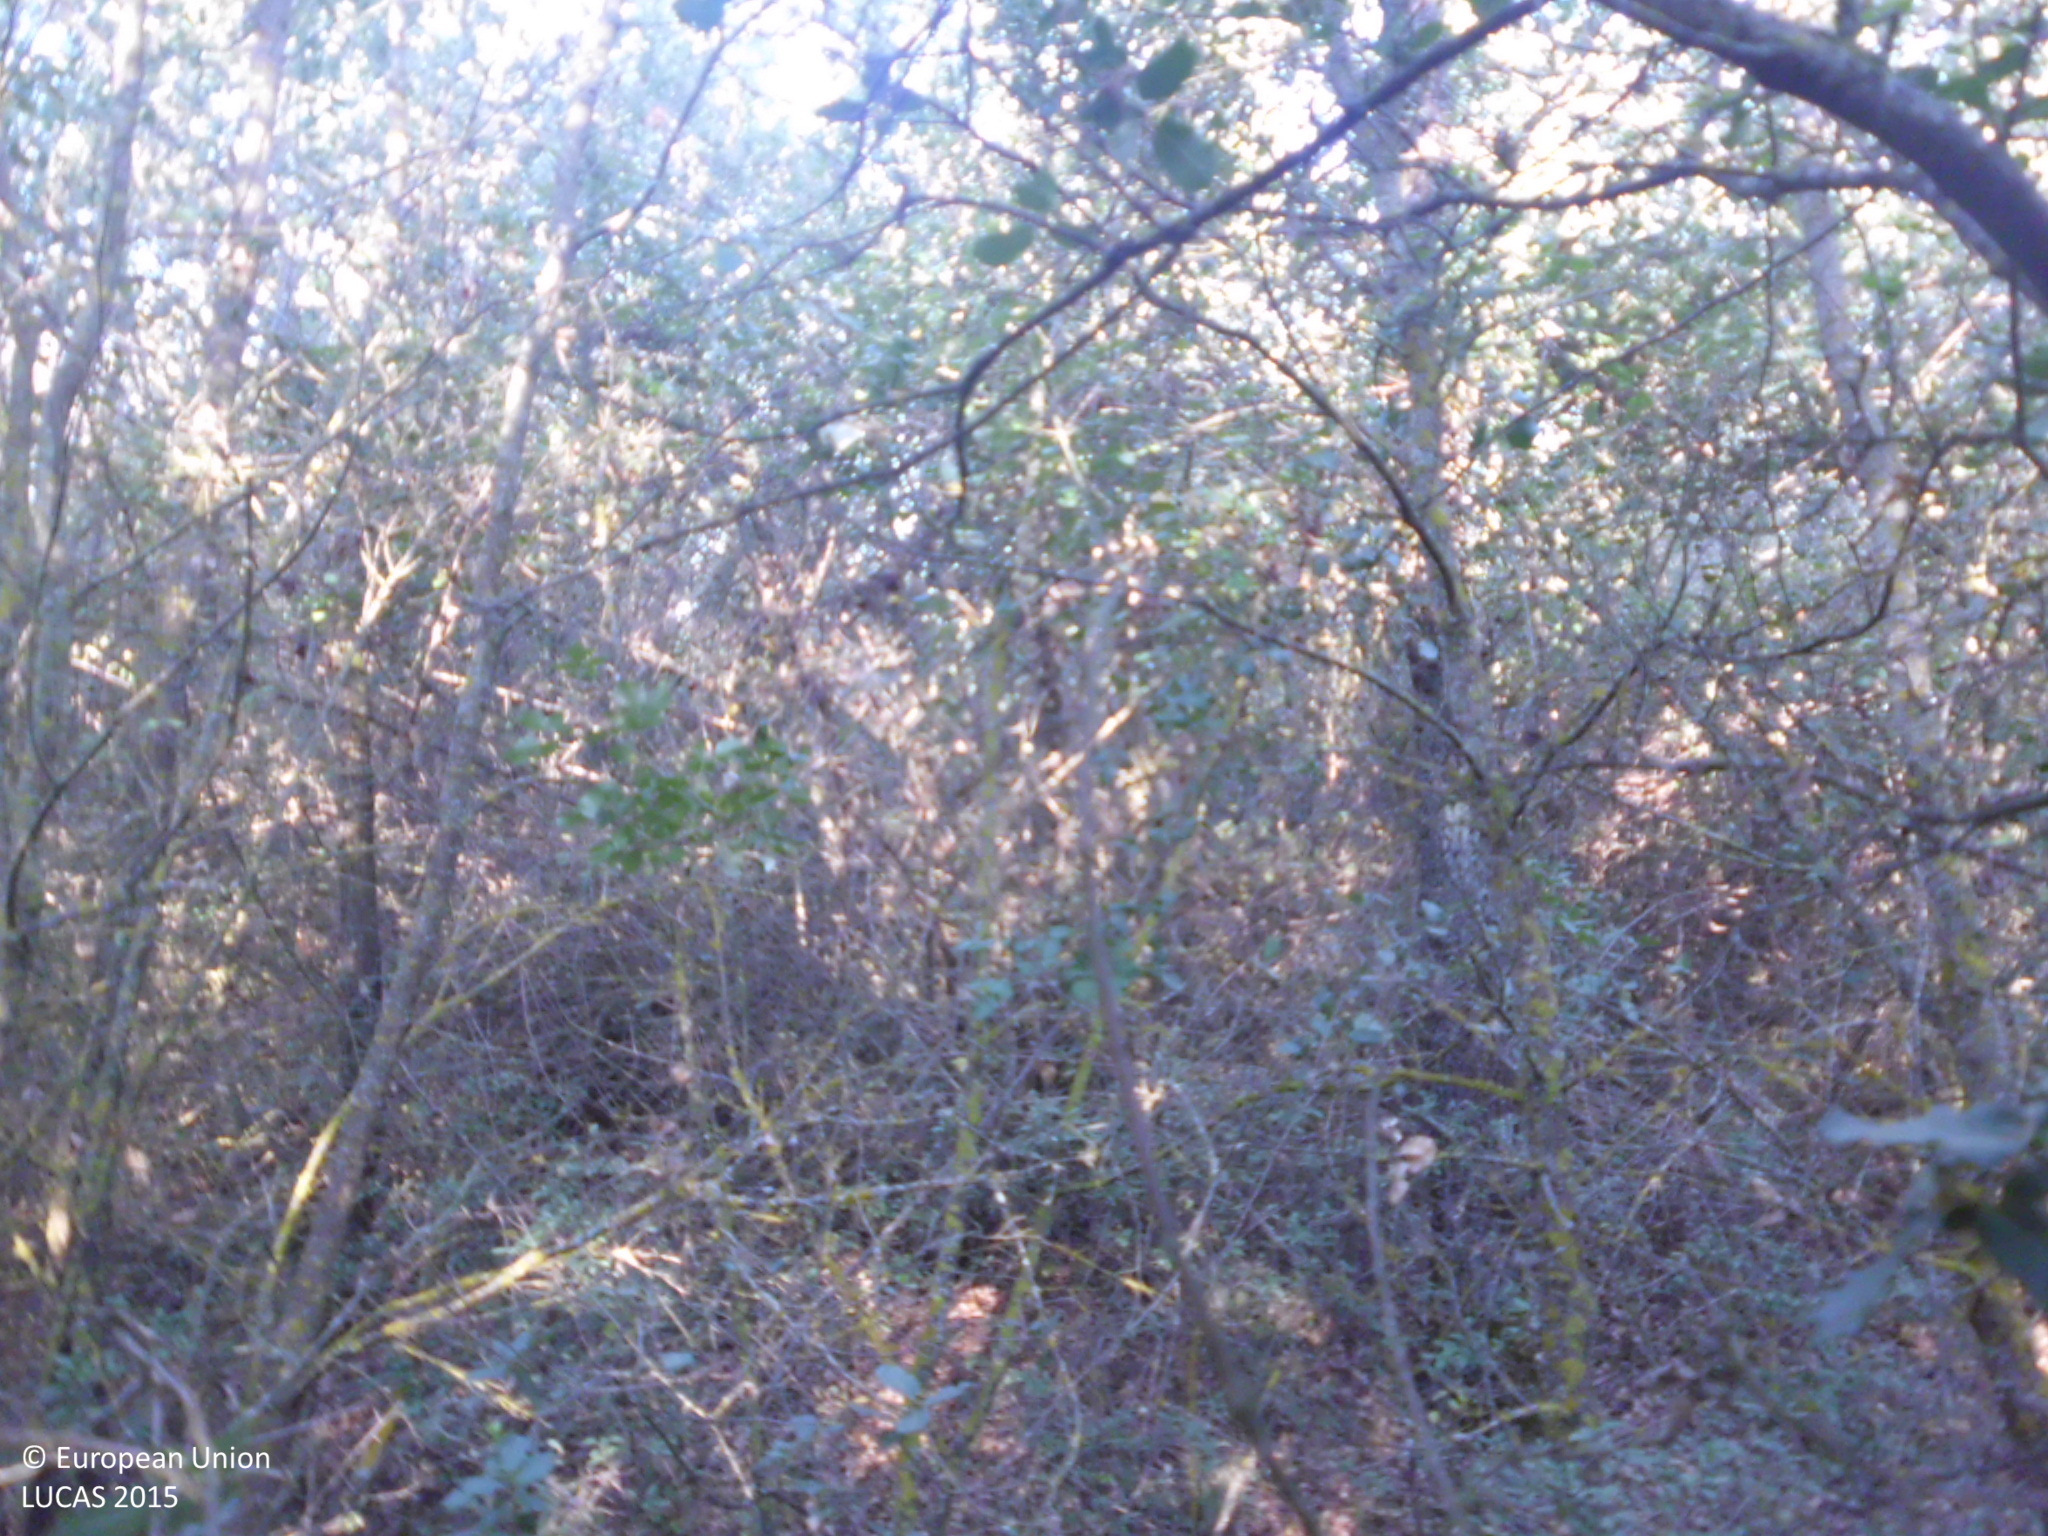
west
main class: Woodland
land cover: Broadleaved woodland
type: broadleaved evergreen forest
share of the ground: > 75 %
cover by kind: broadleaved forest trees 100 %
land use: Forestry
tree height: > 5 m
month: July
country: ES
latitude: 42.2736
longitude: -3.6510
